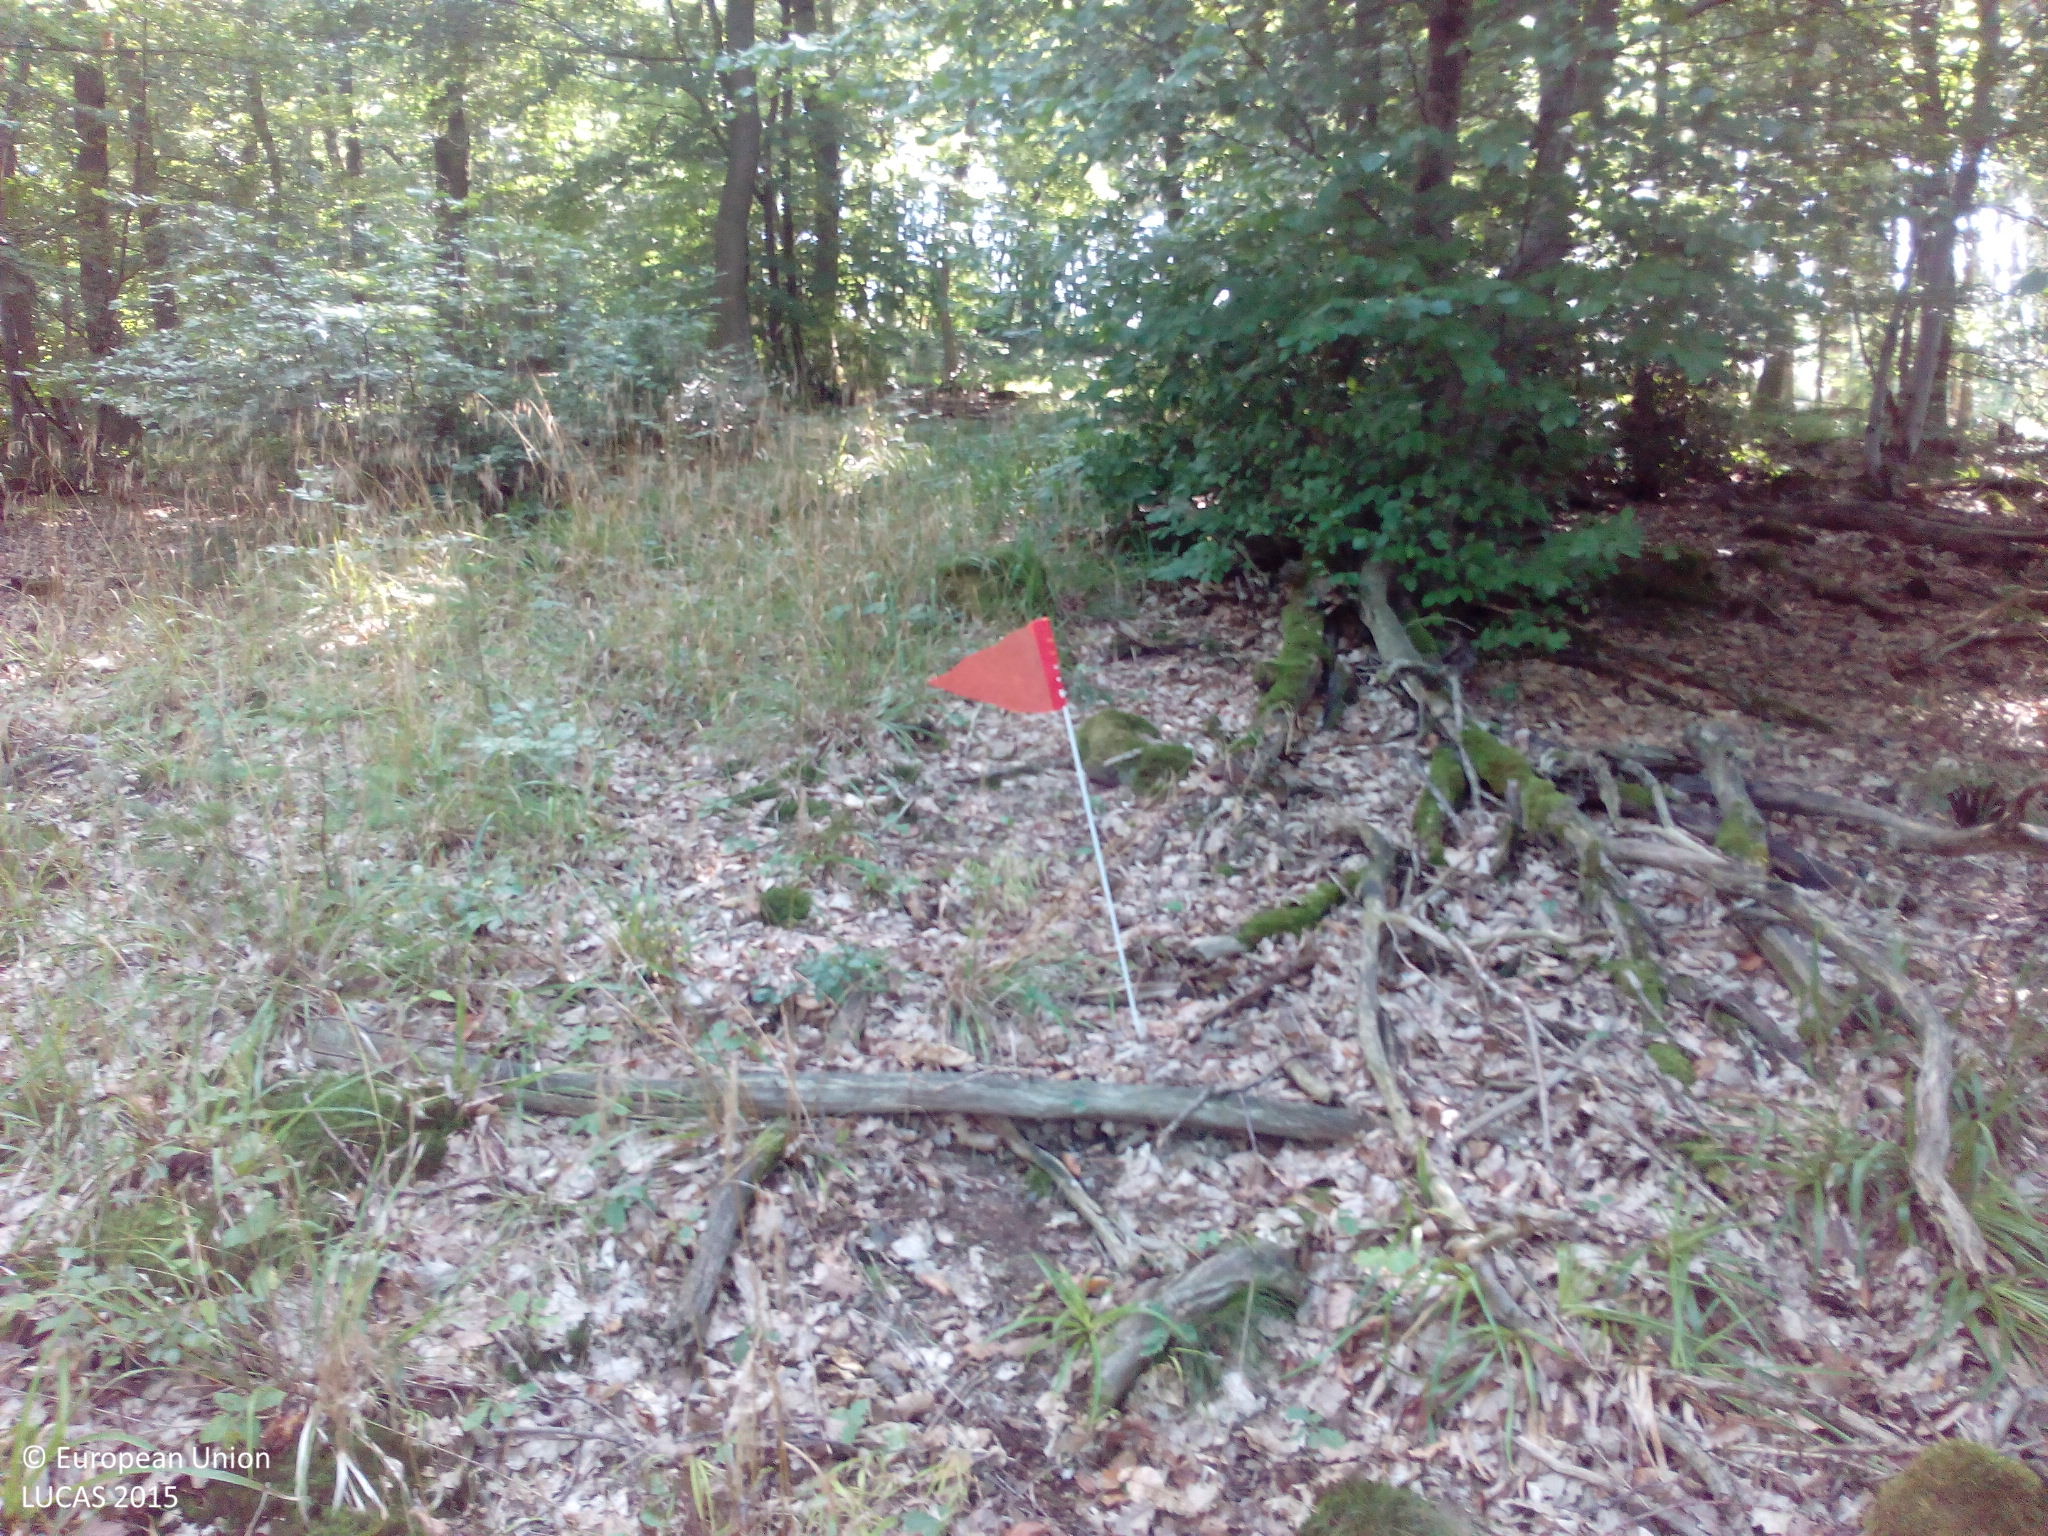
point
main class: Woodland
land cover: Broadleaved woodland
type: mesophytic deciduous forest
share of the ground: > 75 %
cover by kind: broadleaved forest trees 80 %, unconsolidated bare surface 10 %, herbaceous plants 5 %, lichens and mosses 5 %
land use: Forestry
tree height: > 5 m
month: August
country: DE
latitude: 50.2639
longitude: 7.4611
